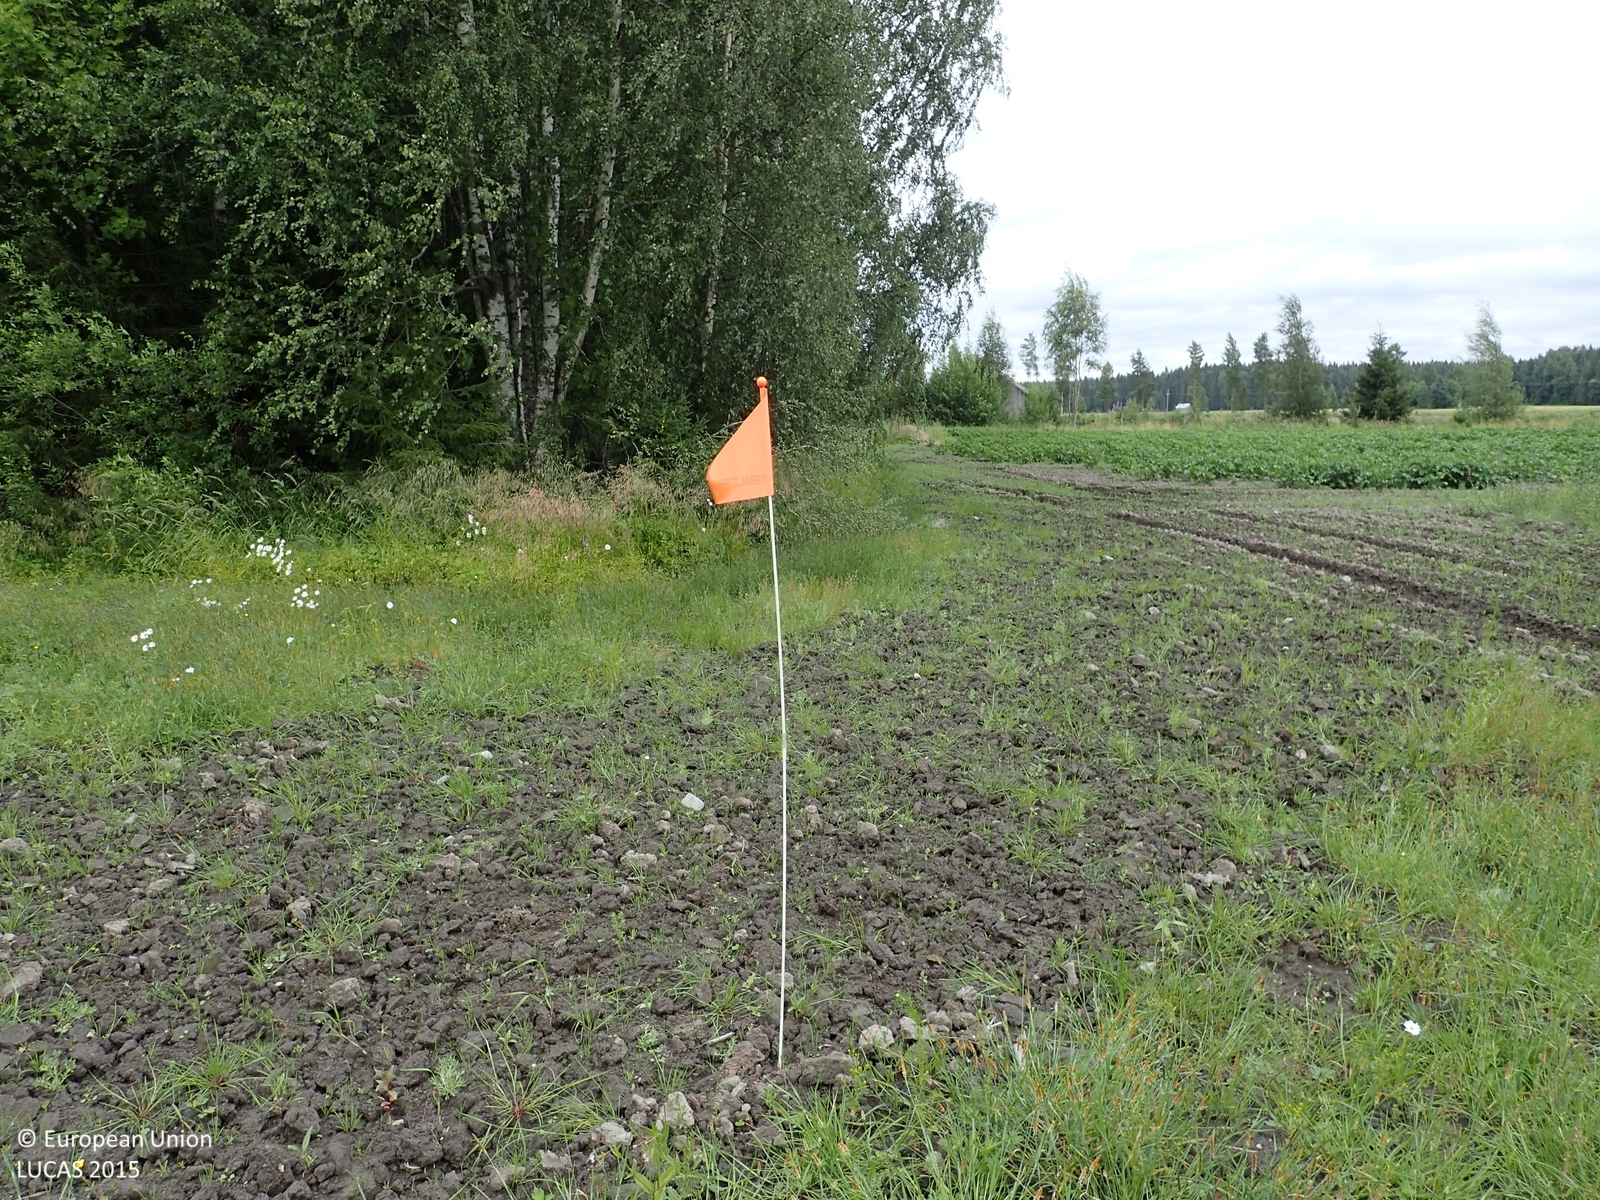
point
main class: Grassland
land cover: Spontaneously vegetated surfaces
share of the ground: 50 - 75 %
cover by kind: herbaceous plants 70 %, unconsolidated bare surface 30 %
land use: Fallow land
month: August
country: FI
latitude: 62.9400
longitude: 22.1652
